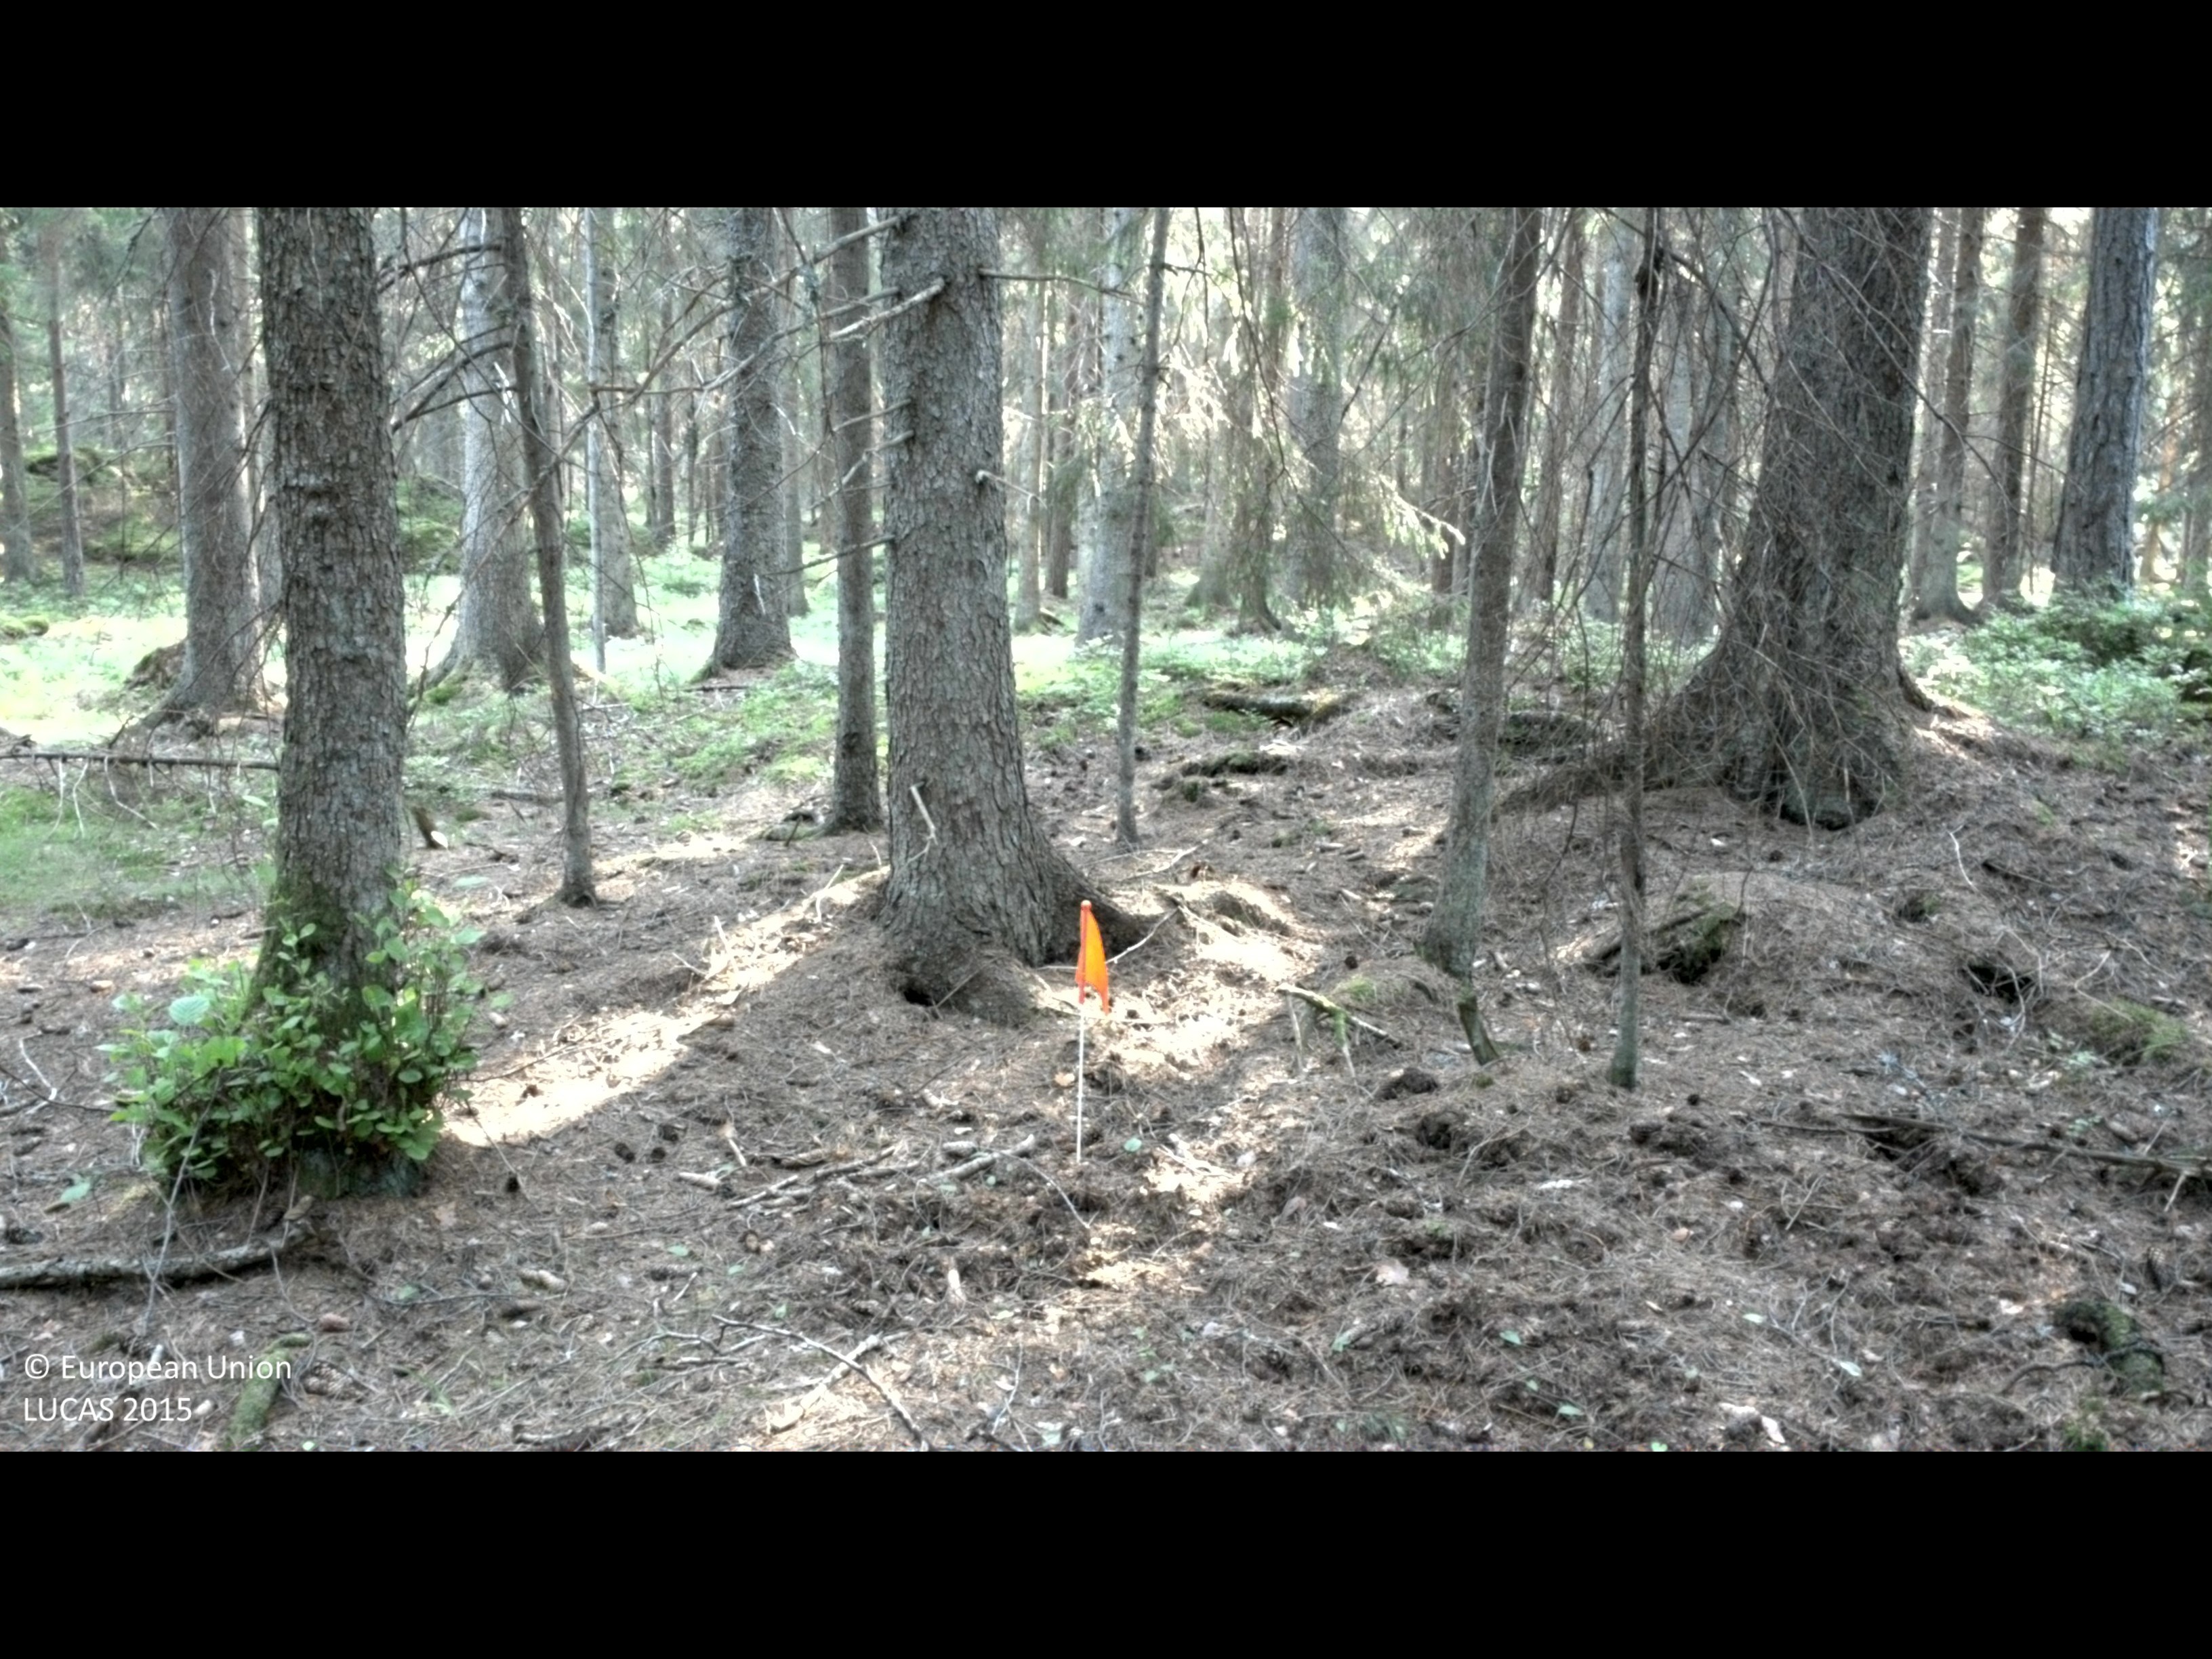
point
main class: Woodland
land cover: Spruce dominated coniferous woodland
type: boreal forest
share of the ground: > 75 %
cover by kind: coniferous forest trees 85 %, shrubs 10 %, lichens and mosses 5 %
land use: Forestry
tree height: > 5 m
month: July
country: SE
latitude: 58.2547
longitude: 16.6260
